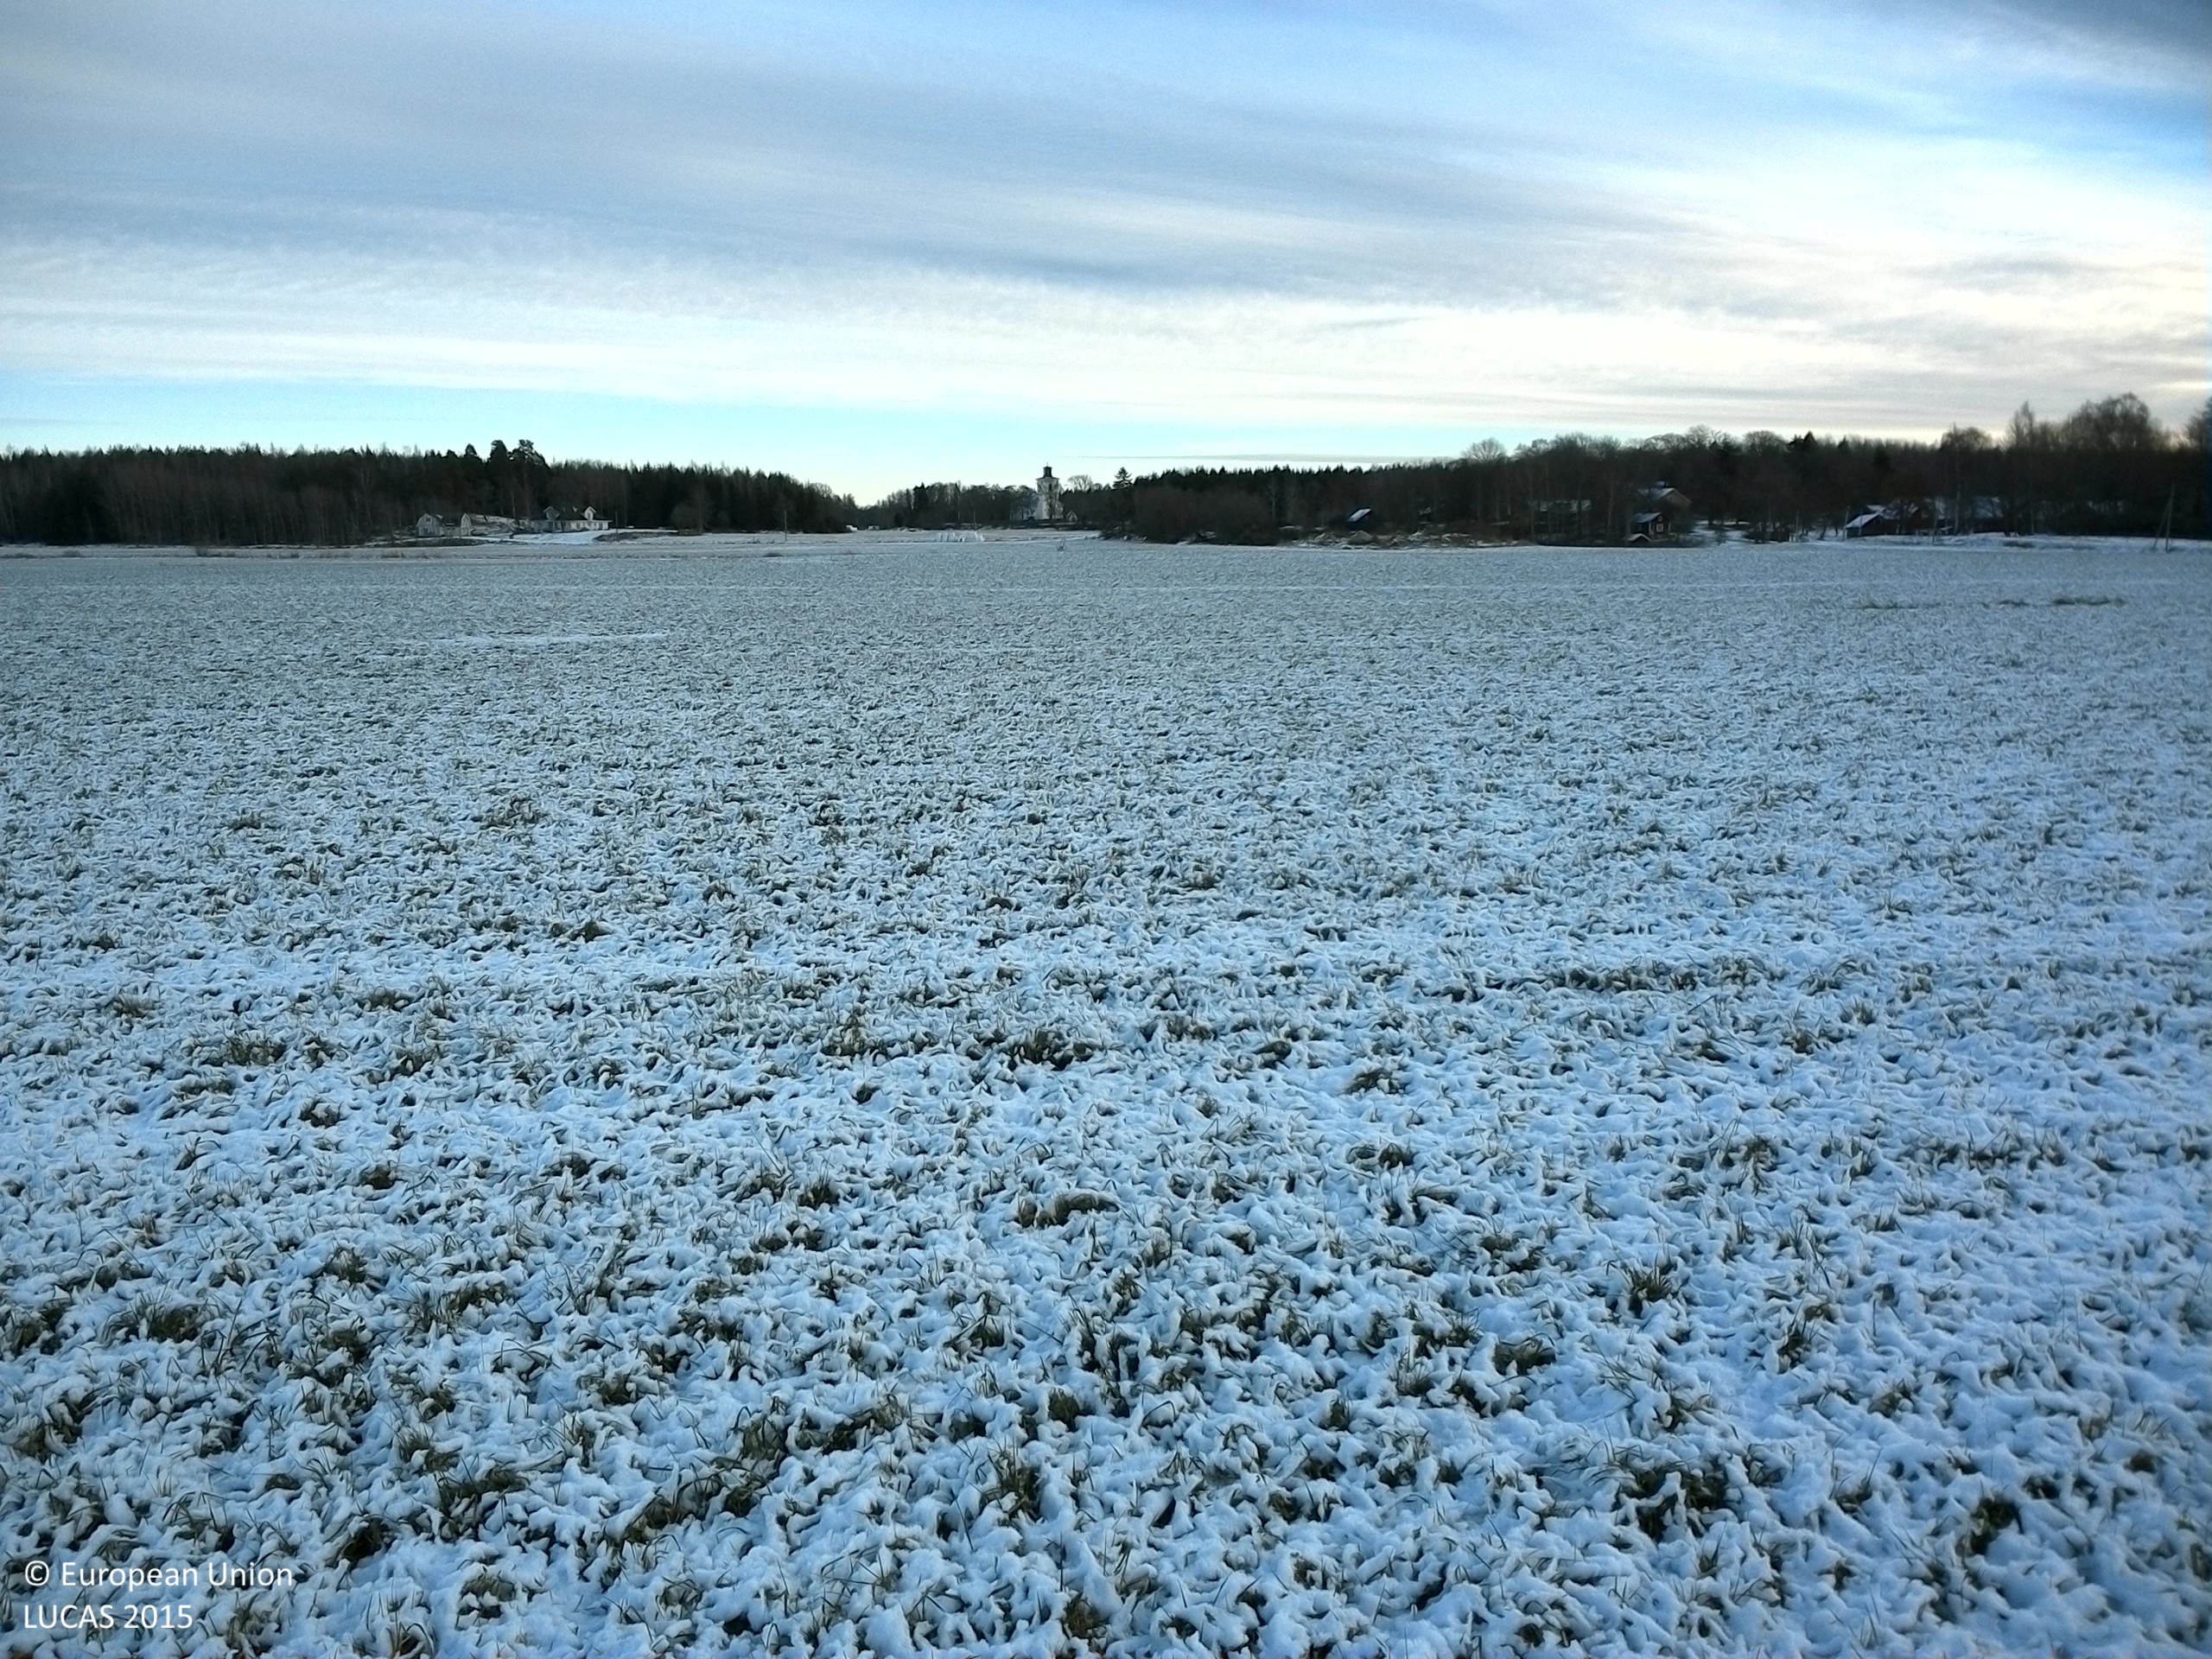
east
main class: Cropland
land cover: Common wheat
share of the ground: > 75 %
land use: Agriculture (excluding fallow land and kitchen gardens)
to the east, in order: Common wheat
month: December
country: SE
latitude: 59.4966
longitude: 16.3330
